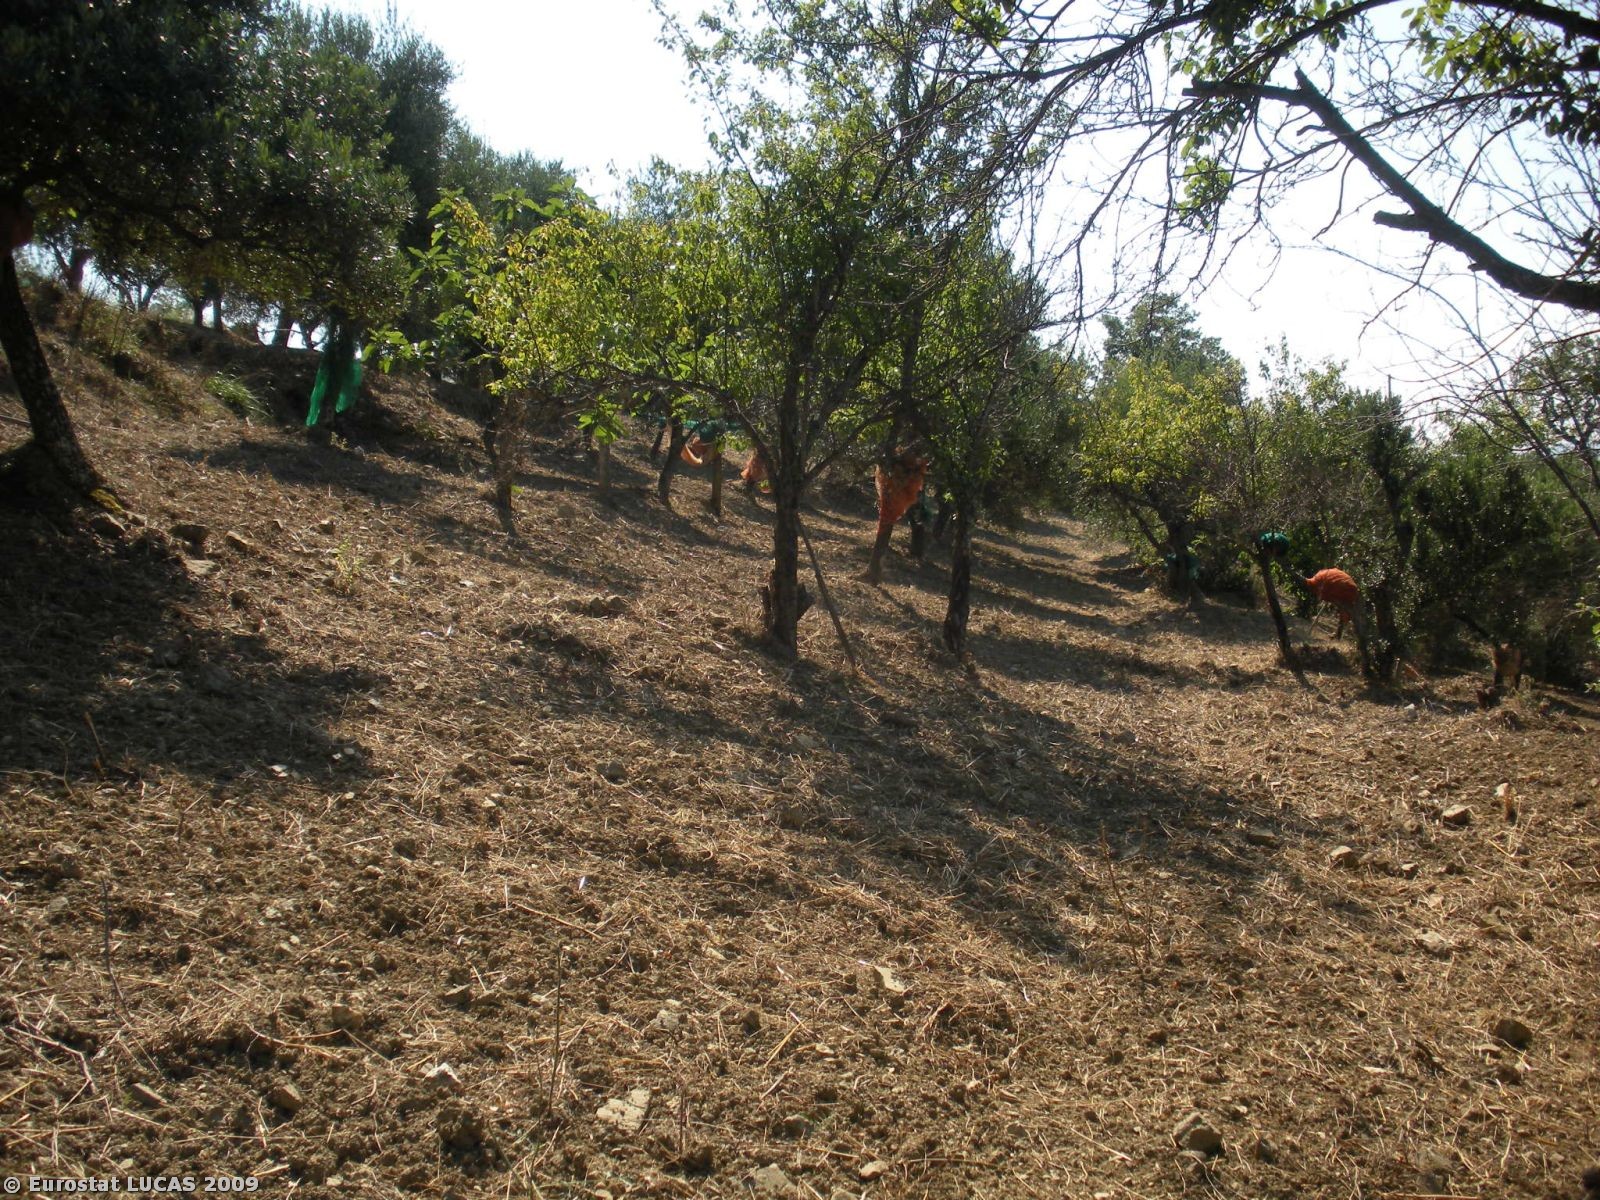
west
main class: Cropland
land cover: Olive groves
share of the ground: 50 - 75 %
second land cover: Other fruit trees and berries
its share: 25 - 50 %
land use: Agriculture (excluding fallow land and kitchen gardens)
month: July
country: IT
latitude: 40.2114
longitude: 15.0180
